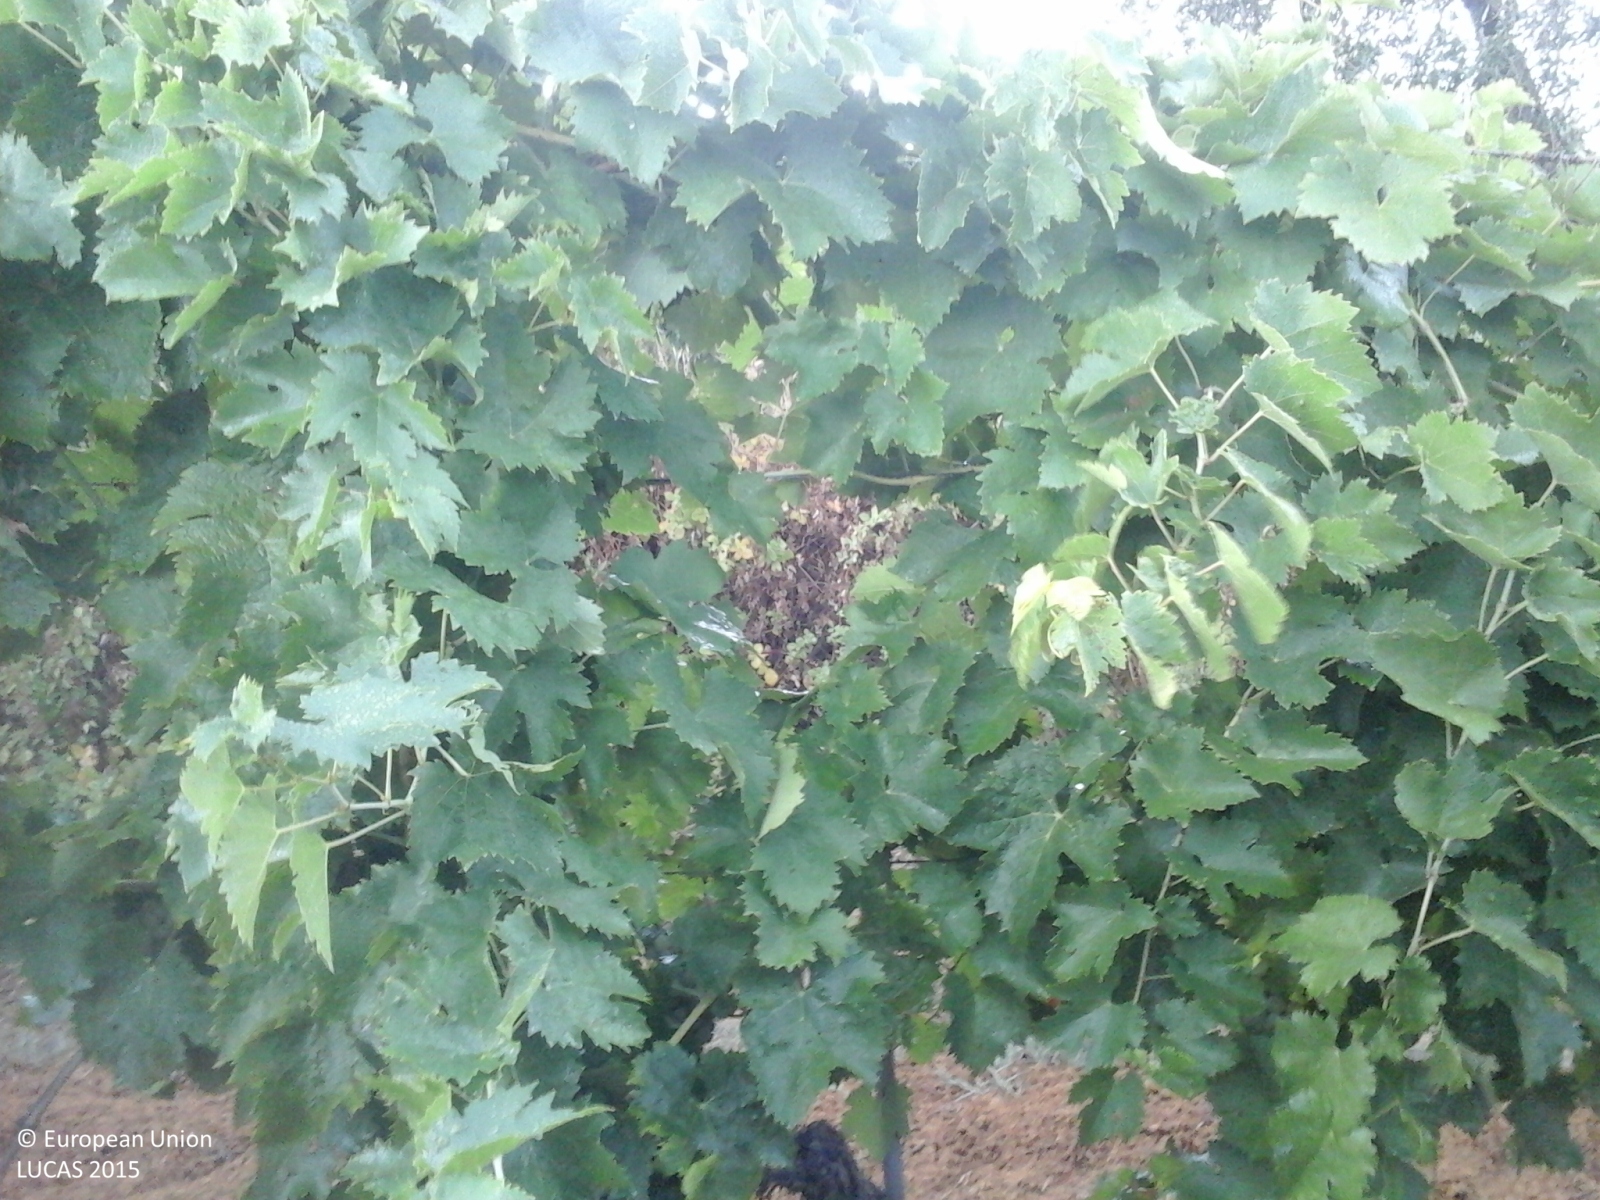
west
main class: Cropland
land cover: Vineyards
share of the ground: > 75 %
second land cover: Other bare soil
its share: > 75 %
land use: Agriculture (excluding fallow land and kitchen gardens)
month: August
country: IT
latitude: 43.8419
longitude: 10.8560
